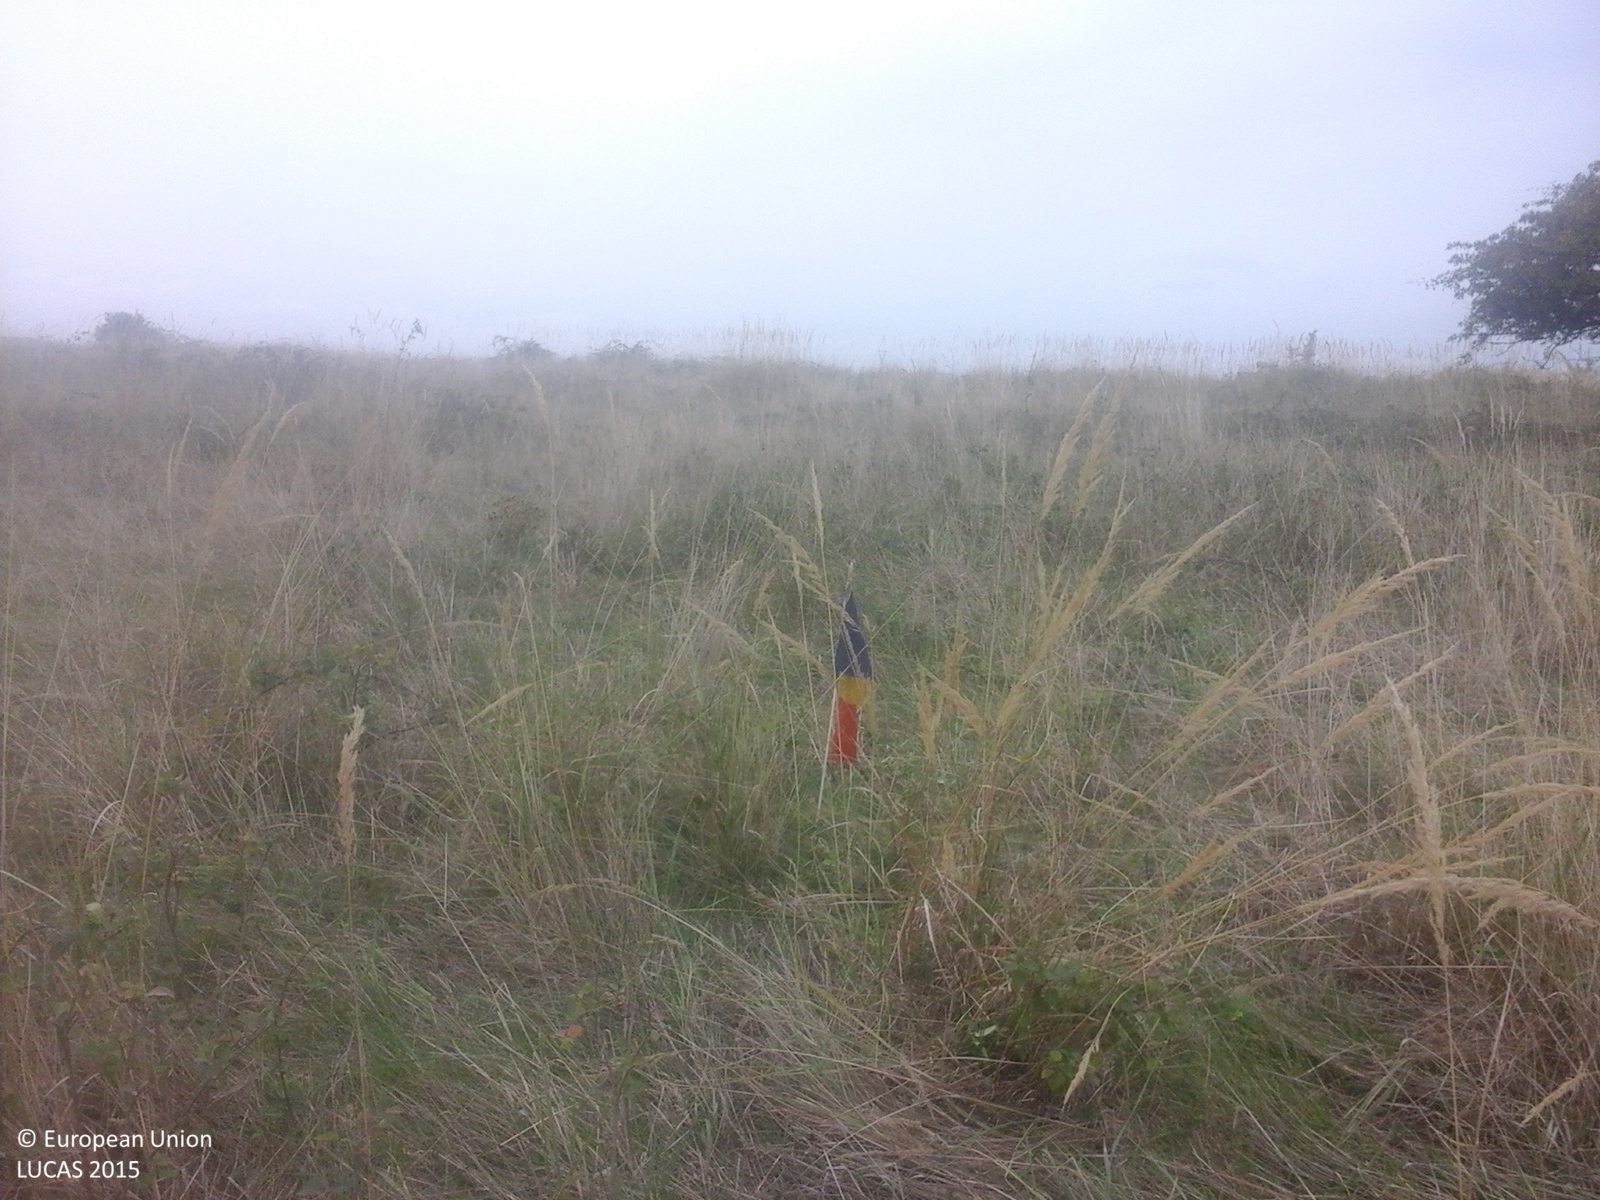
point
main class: Grassland
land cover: Grassland with sparse tree/shrub cover
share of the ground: > 75 %
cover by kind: herbaceous plants 85 %, shrubs 10 %, broadleaved forest trees 5 %
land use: Agriculture (excluding fallow land and kitchen gardens)
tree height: < 5 m
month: September
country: RO
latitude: 45.8605
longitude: 22.1108
